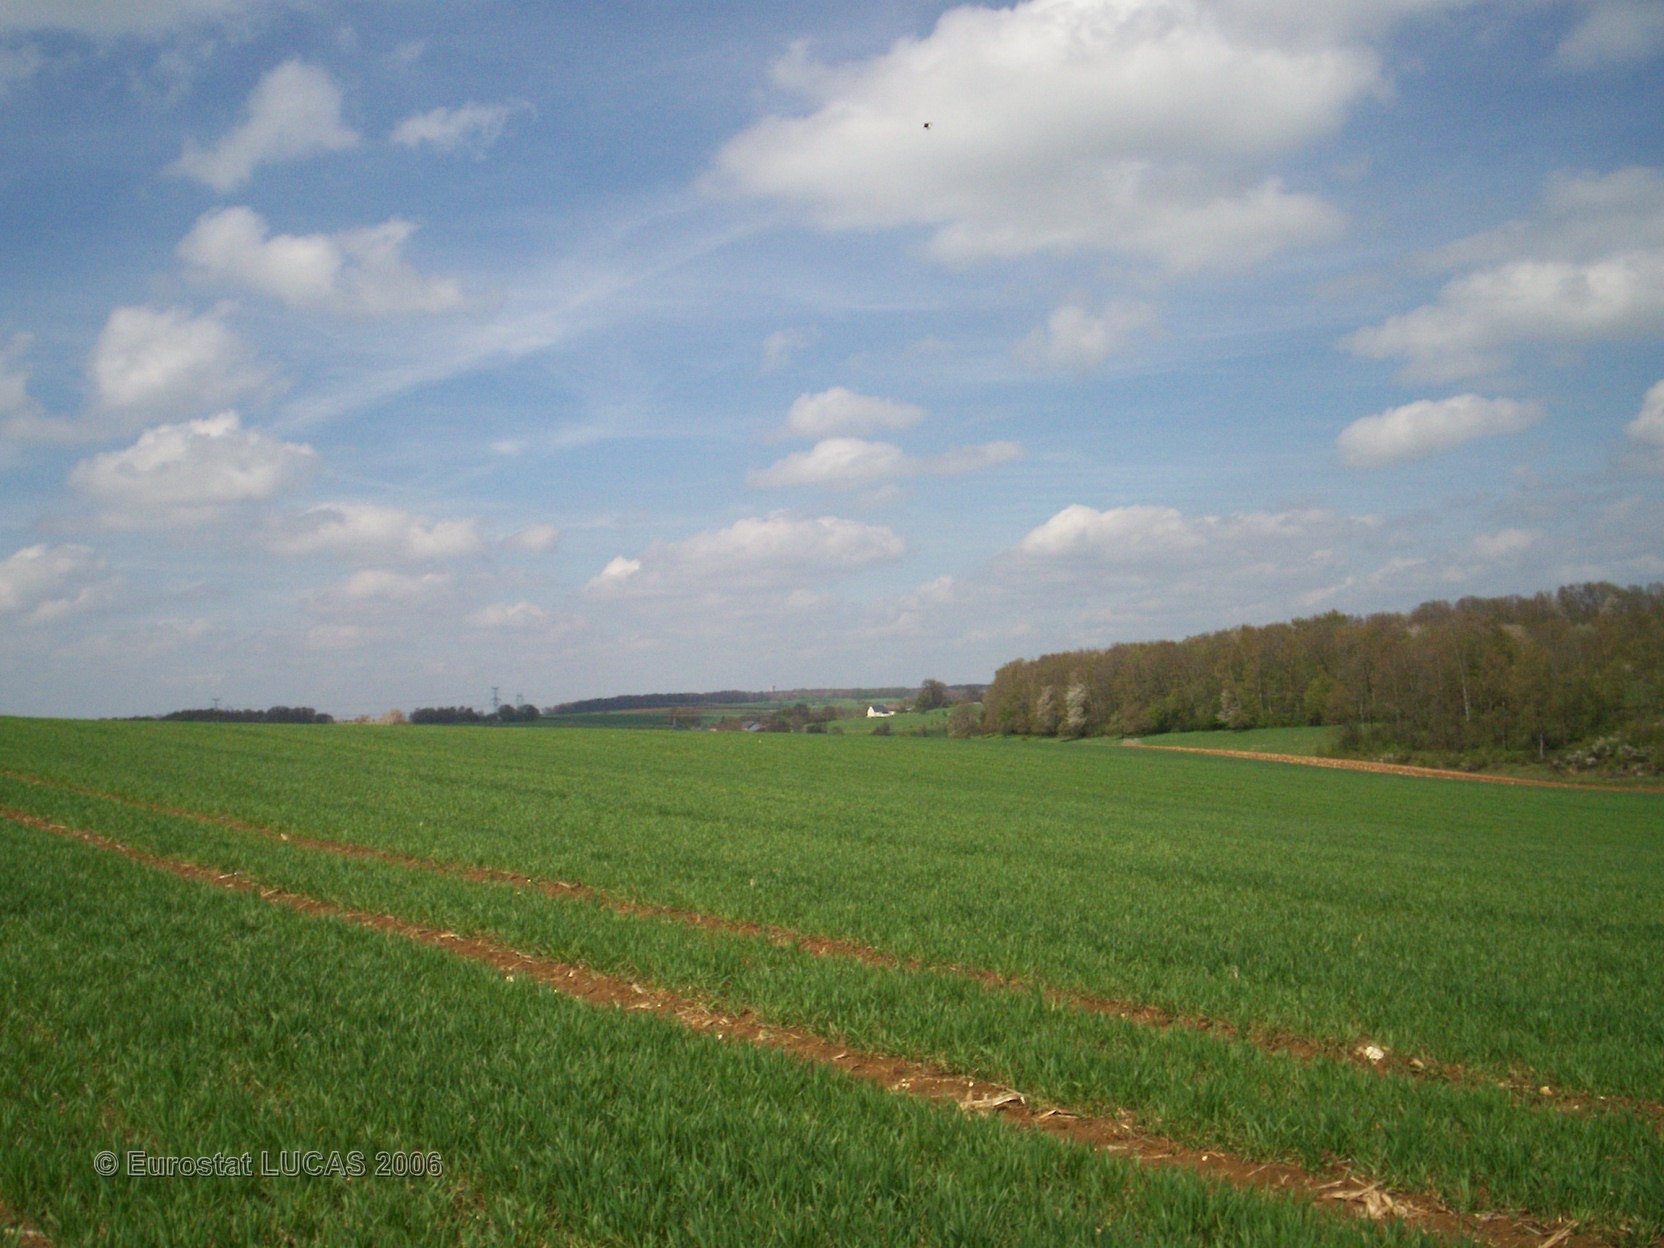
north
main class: Cropland
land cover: Common wheat
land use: Agriculture (excluding fallow land and kitchen gardens)
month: May
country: FR
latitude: 49.7928
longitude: 4.3697
